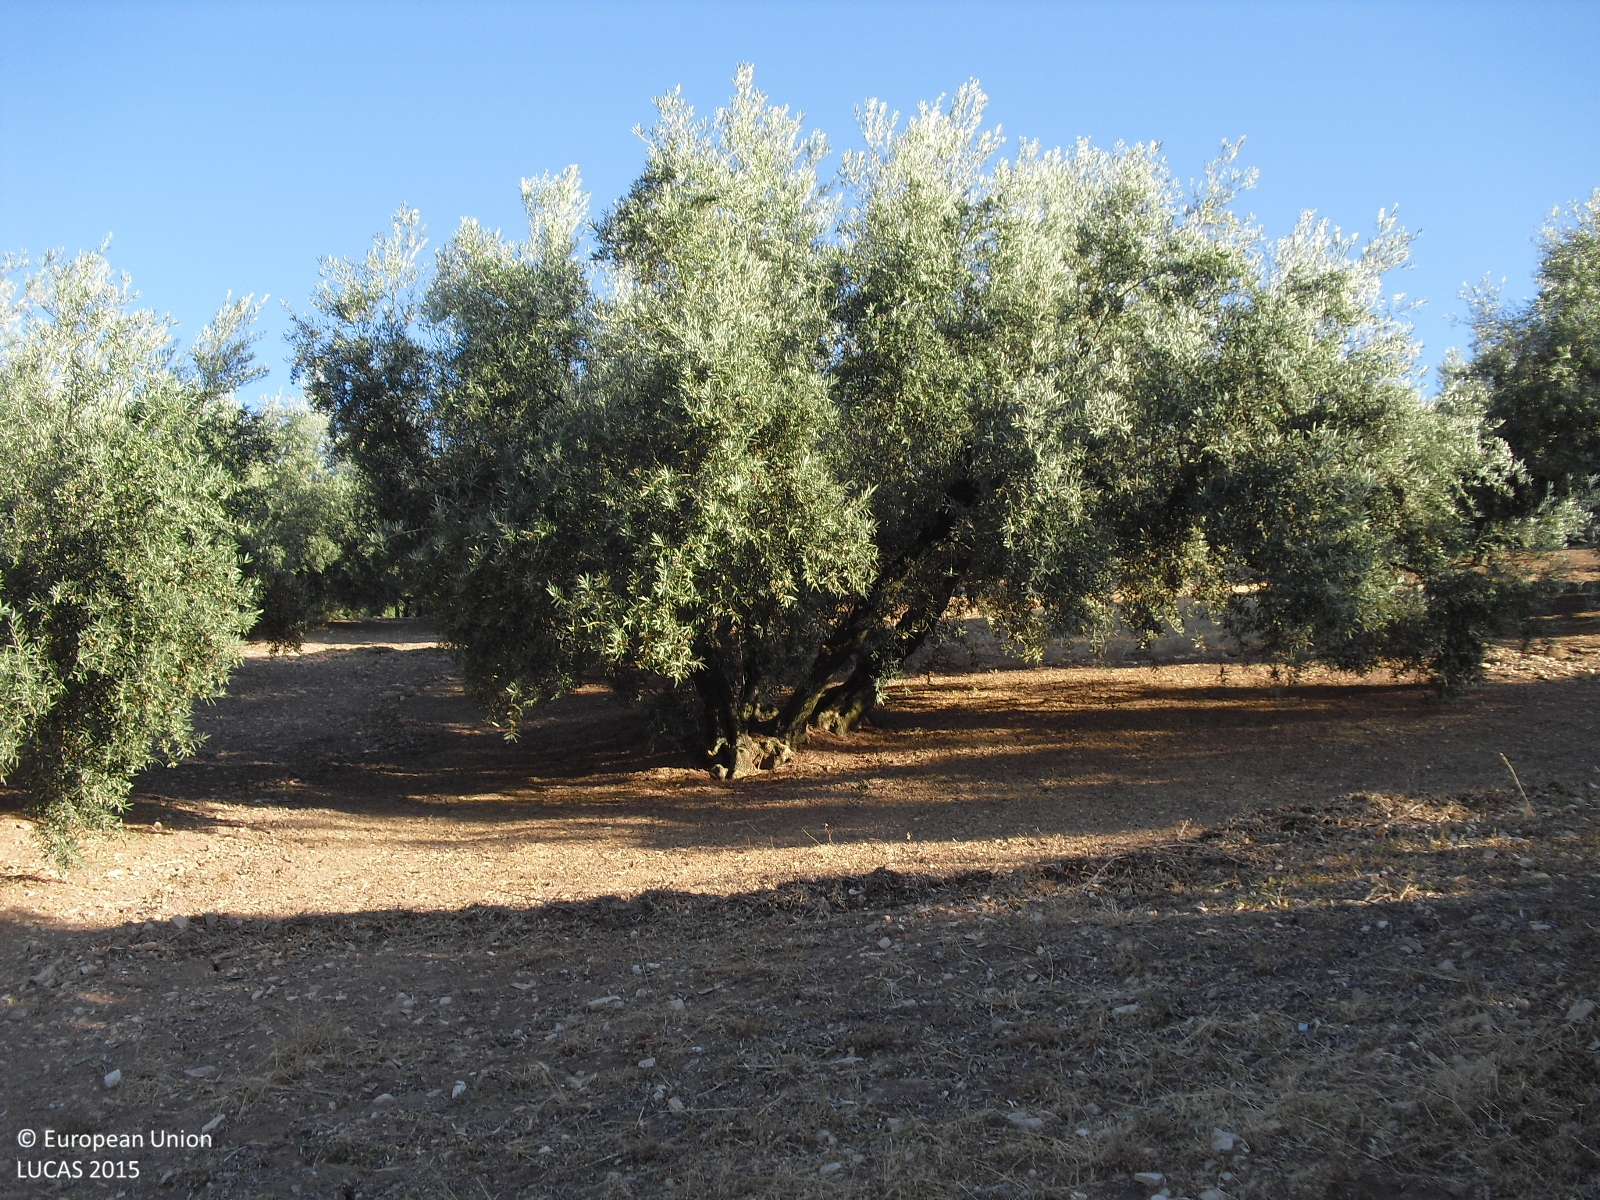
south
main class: Cropland
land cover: Olive groves
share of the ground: 25 - 50 %
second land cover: Other bare soil
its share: > 75 %
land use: Agriculture (excluding fallow land and kitchen gardens)
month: August
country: ES
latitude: 37.2752
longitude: -4.1273
